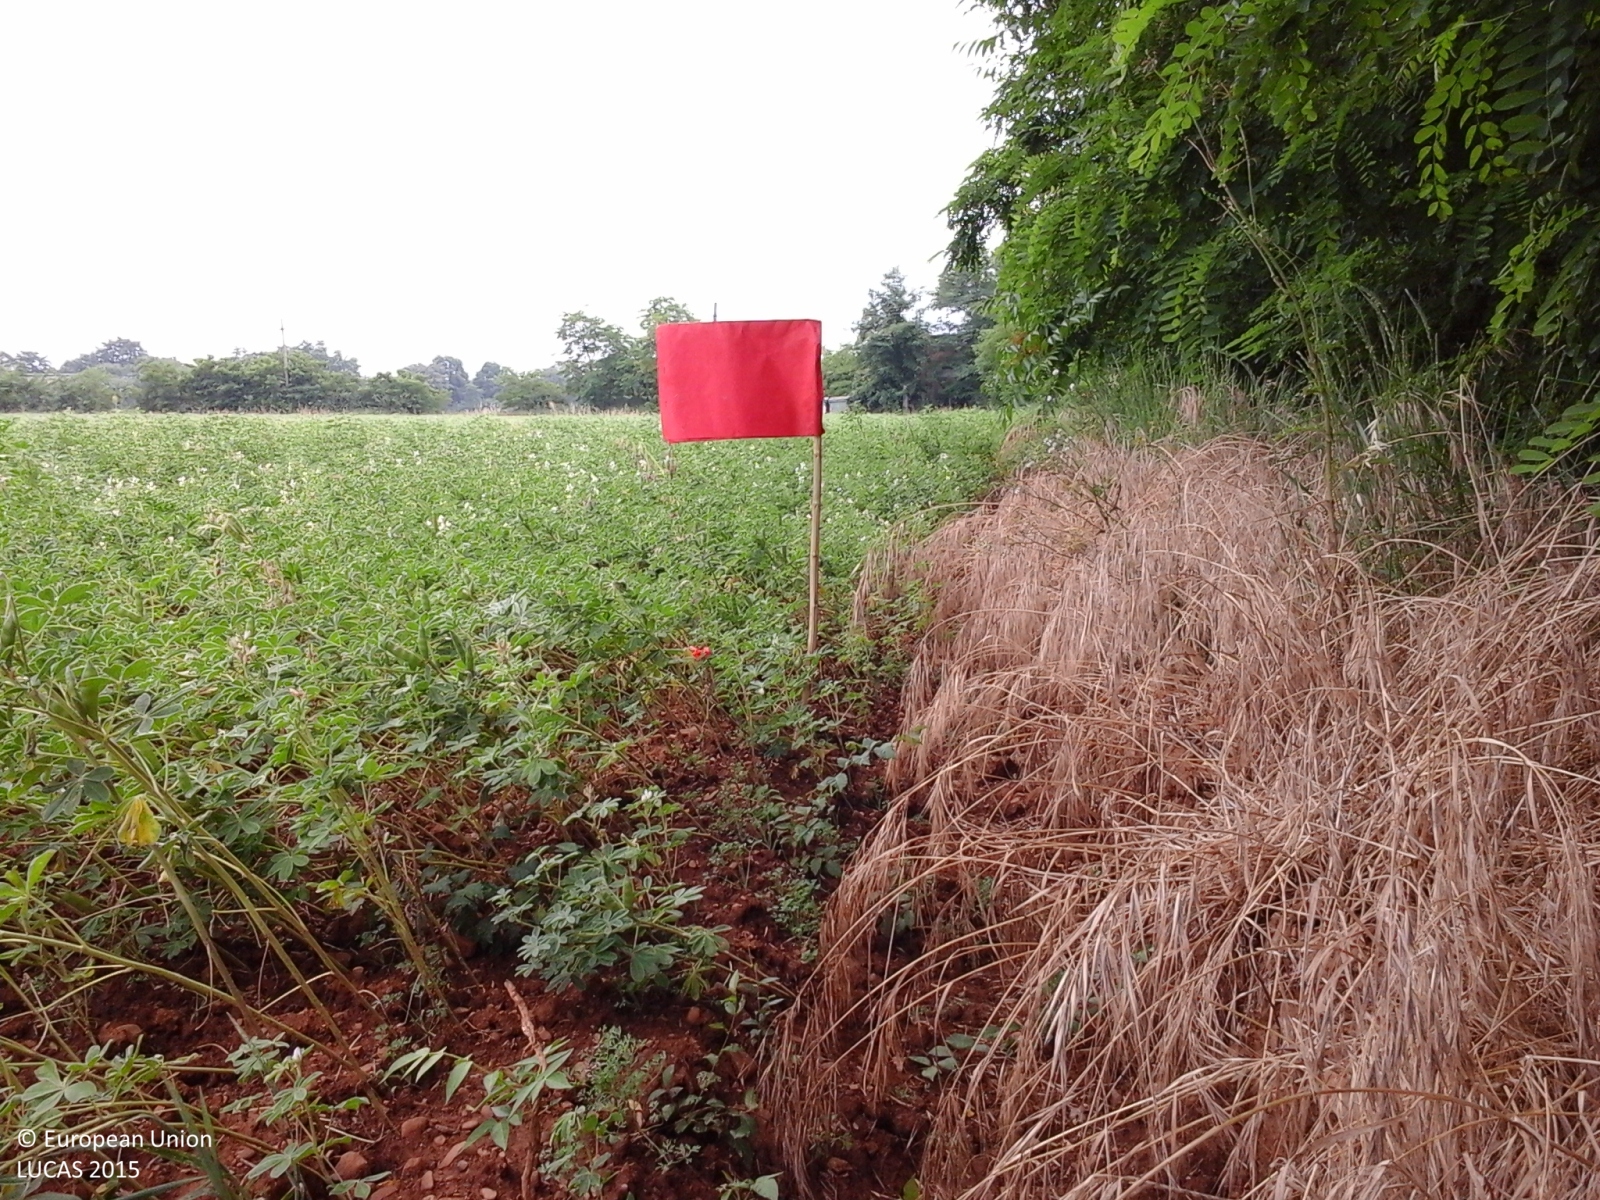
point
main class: Cropland
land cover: Dry pulses
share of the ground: > 75 %
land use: Agriculture (excluding fallow land and kitchen gardens)
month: June
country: IT
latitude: 44.8306
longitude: 8.8008
